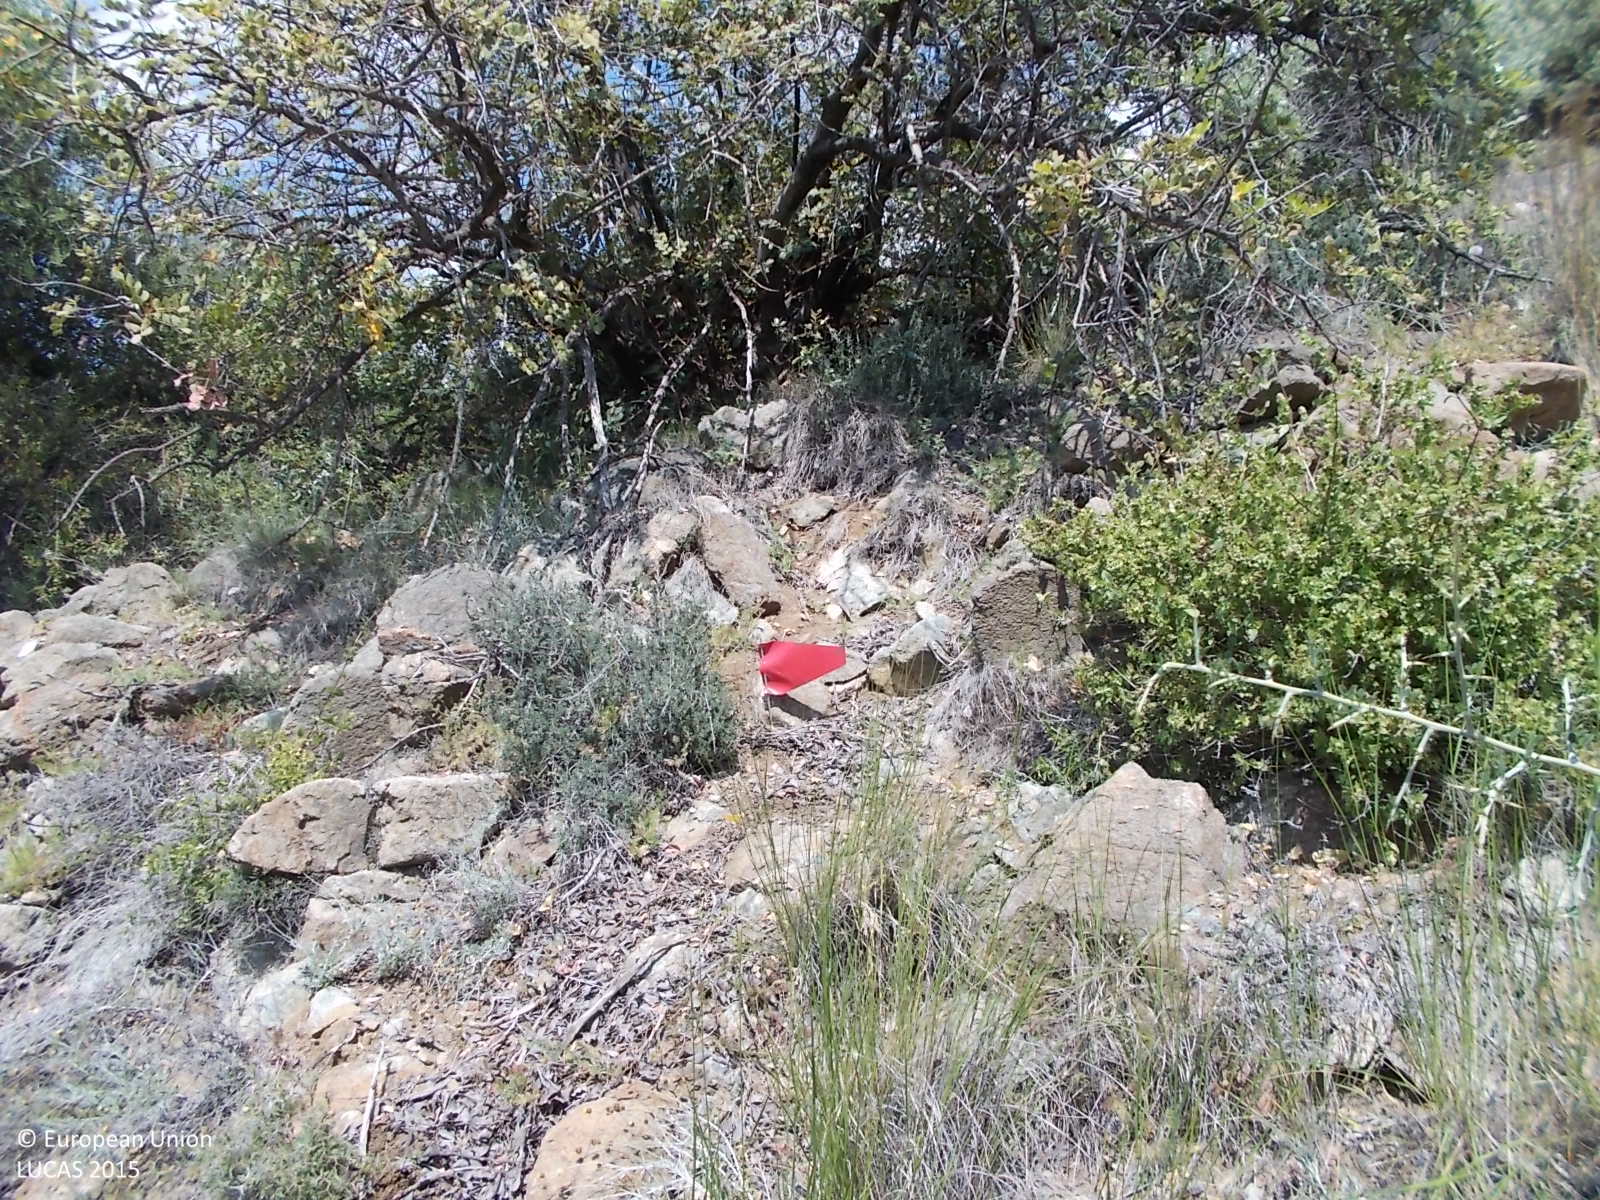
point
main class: Shrubland
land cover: Shrubland with sparse tree cover
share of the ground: > 75 %
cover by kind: shrubs 95 %, broadleaved forest trees 5 %
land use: Semi-natural and natural areas not in use
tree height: > 5 m
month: April
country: CY
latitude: 34.7674
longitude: 33.1036
